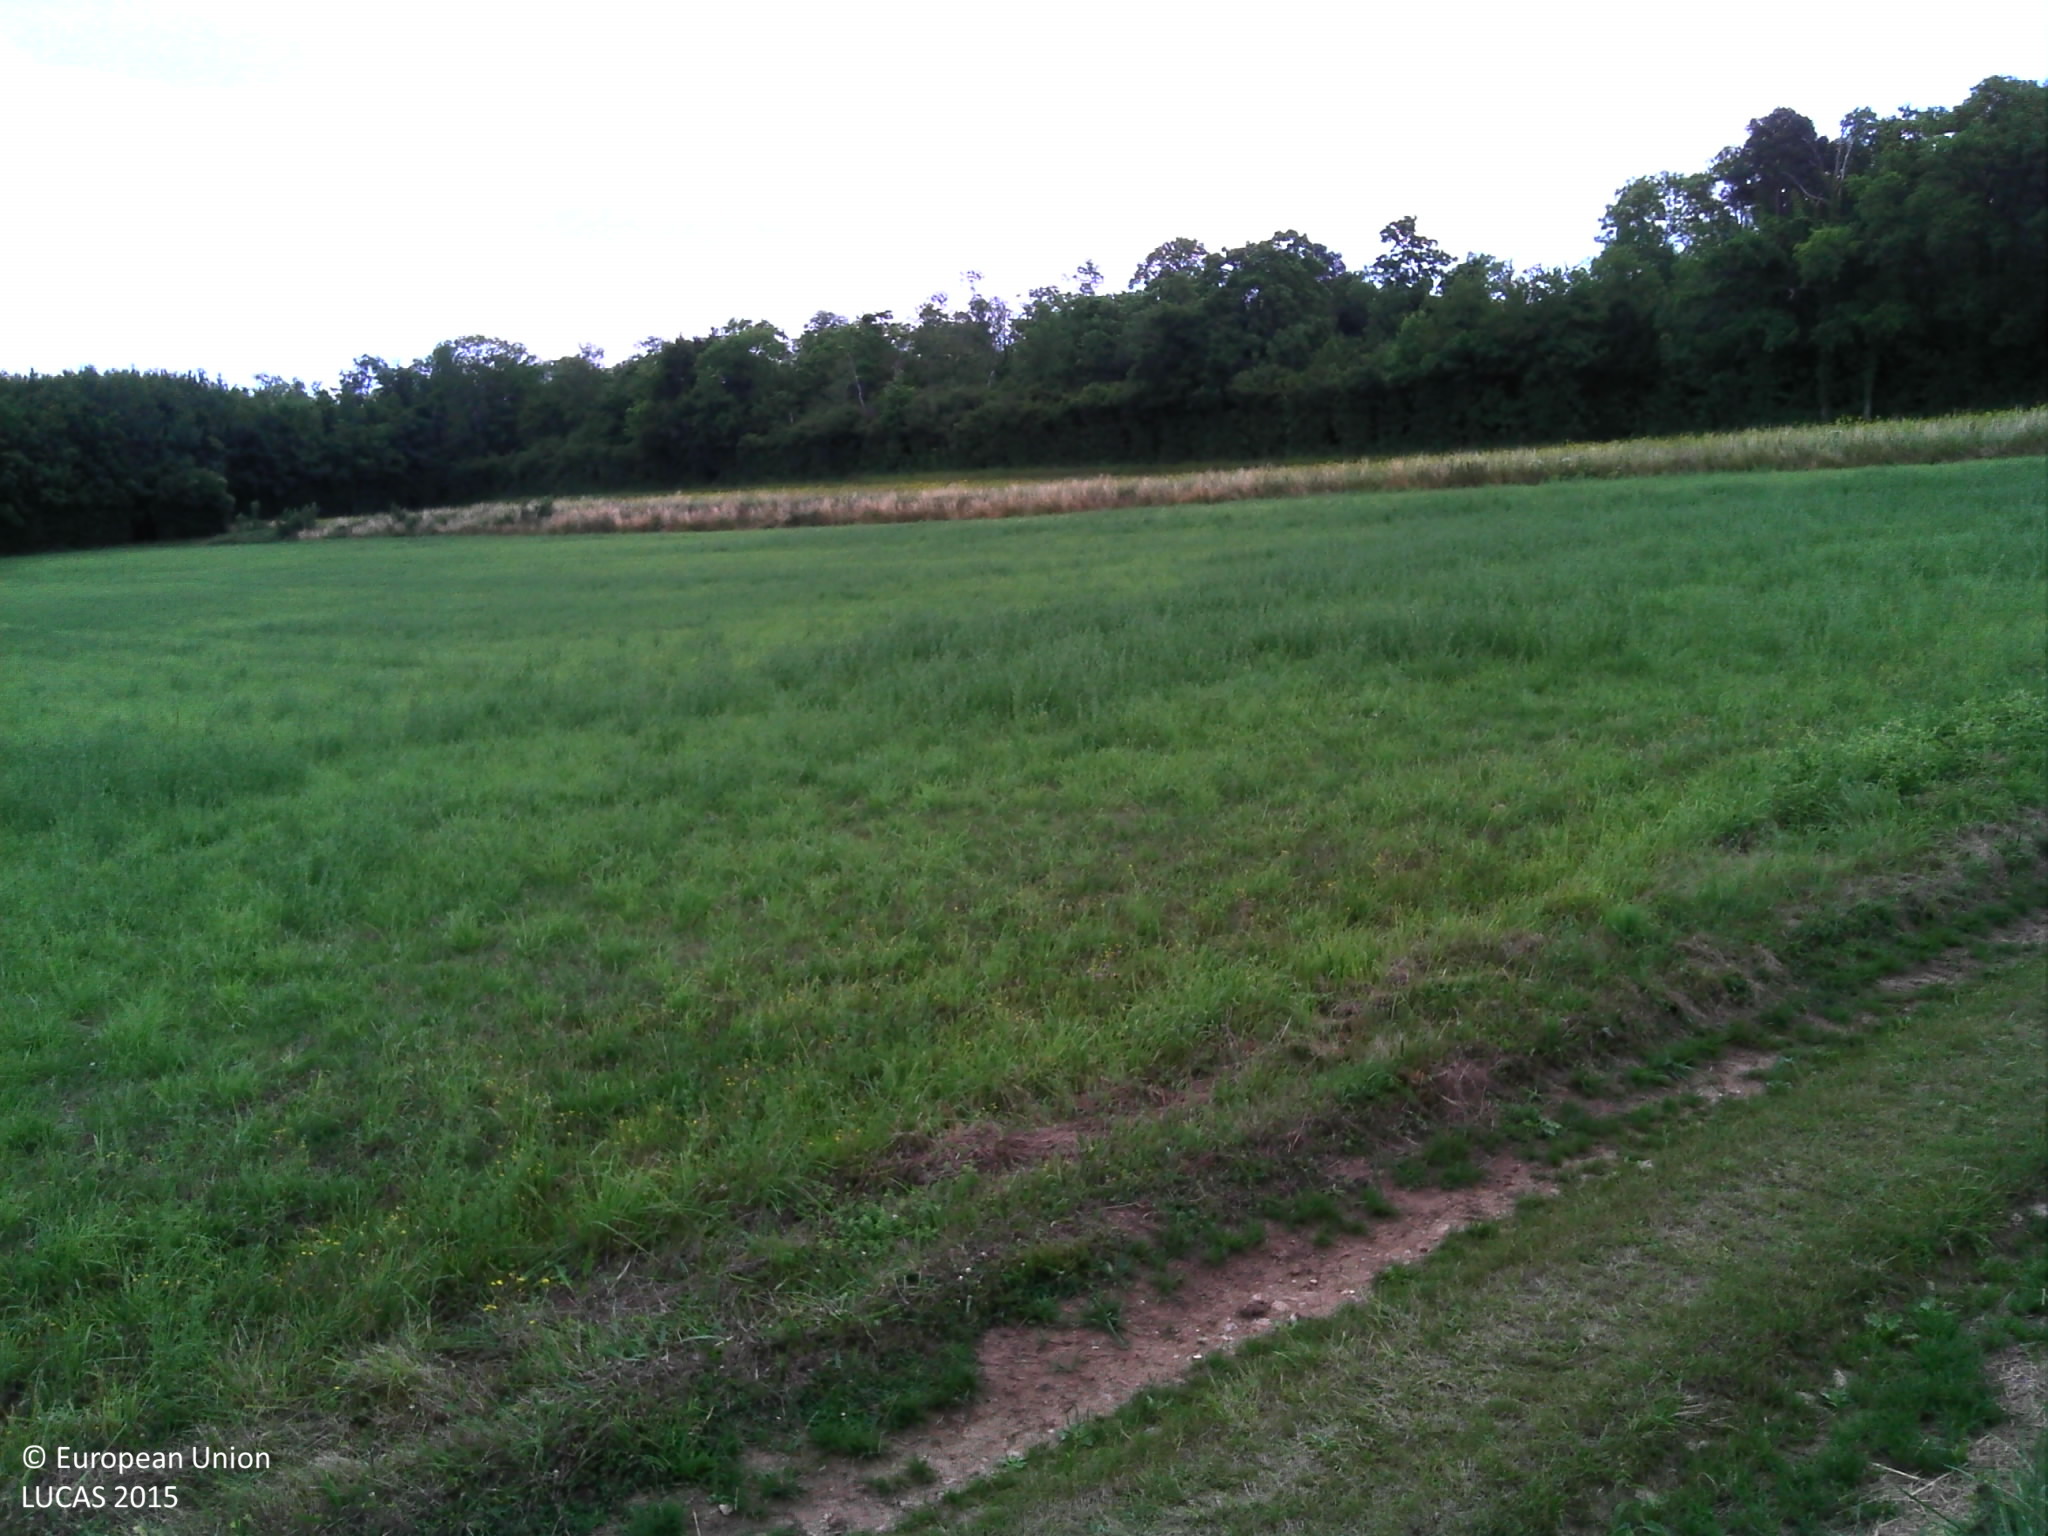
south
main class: Cropland
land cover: Rape and turnip rape
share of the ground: > 75 %
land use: Agriculture (excluding fallow land and kitchen gardens)
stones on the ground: < 10 %
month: July
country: FR
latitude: 48.9812
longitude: -0.2123
